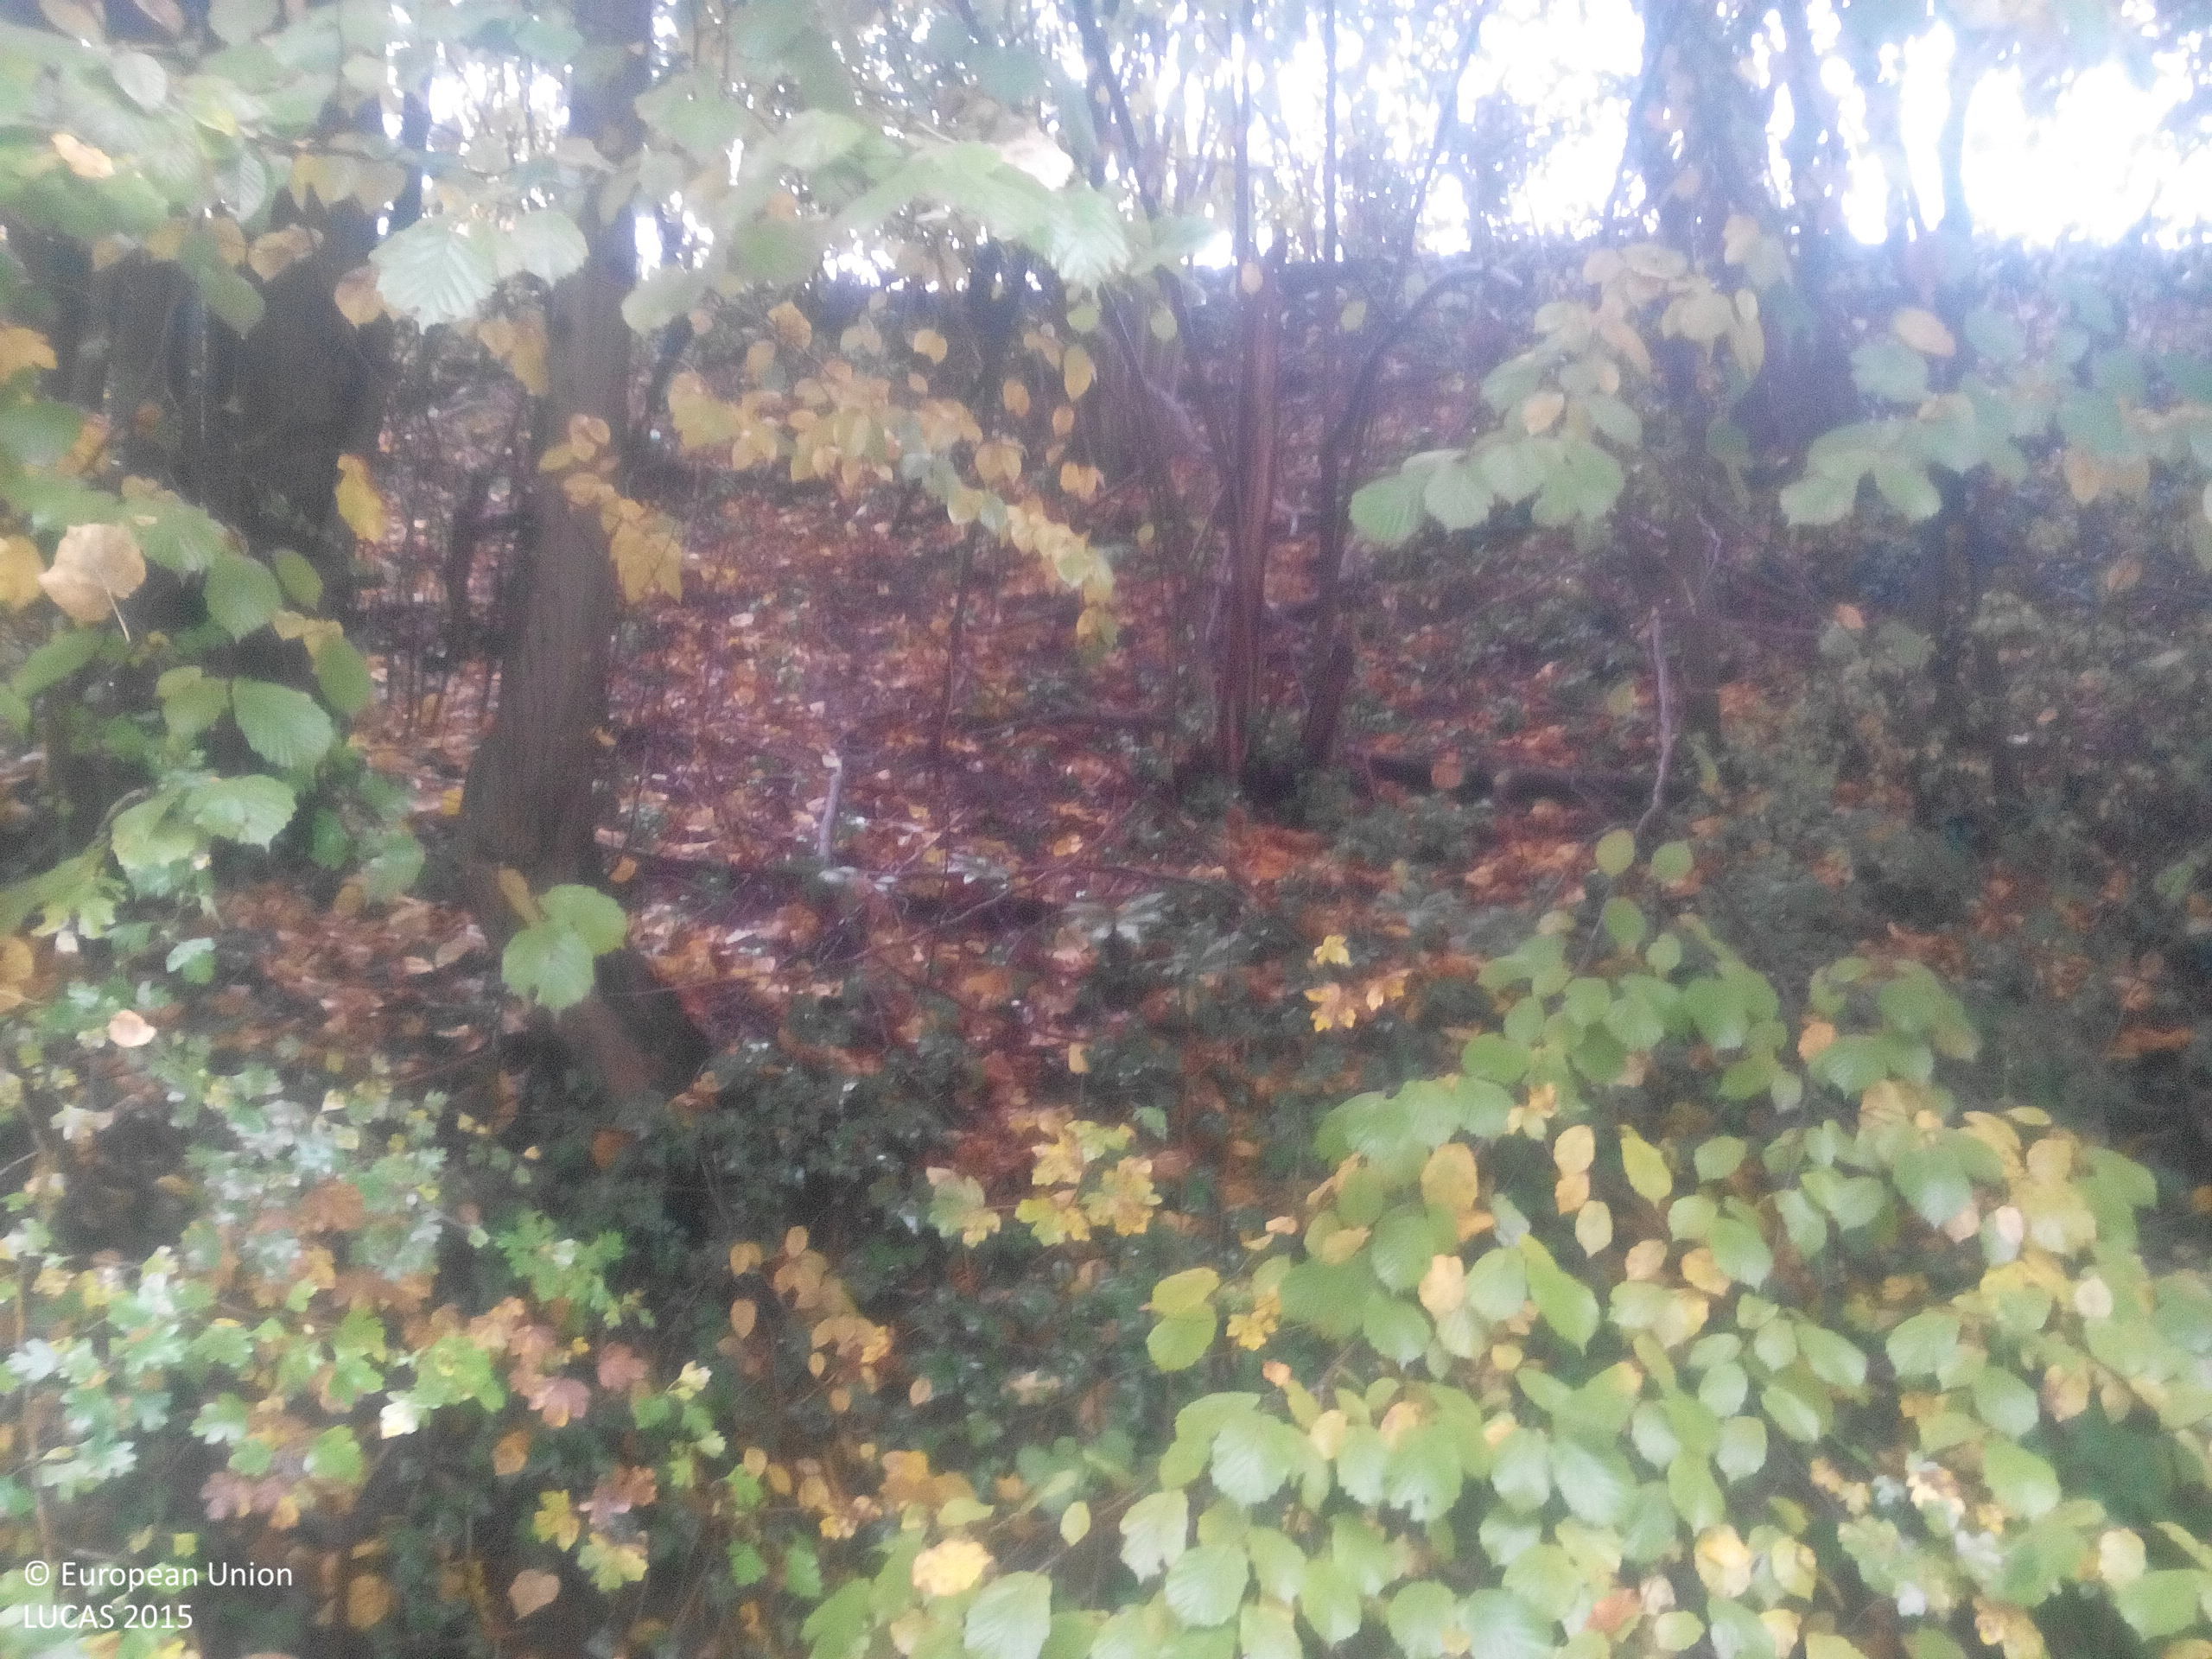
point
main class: Woodland
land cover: Broadleaved woodland
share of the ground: 50 - 75 %
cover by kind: broadleaved forest trees 70 %, herbaceous plants 20 %, shrubs 10 %
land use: Semi-natural and natural areas not in use
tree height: > 5 m
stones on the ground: < 10 %
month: October
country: BG
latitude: 42.9962
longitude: 24.2436
